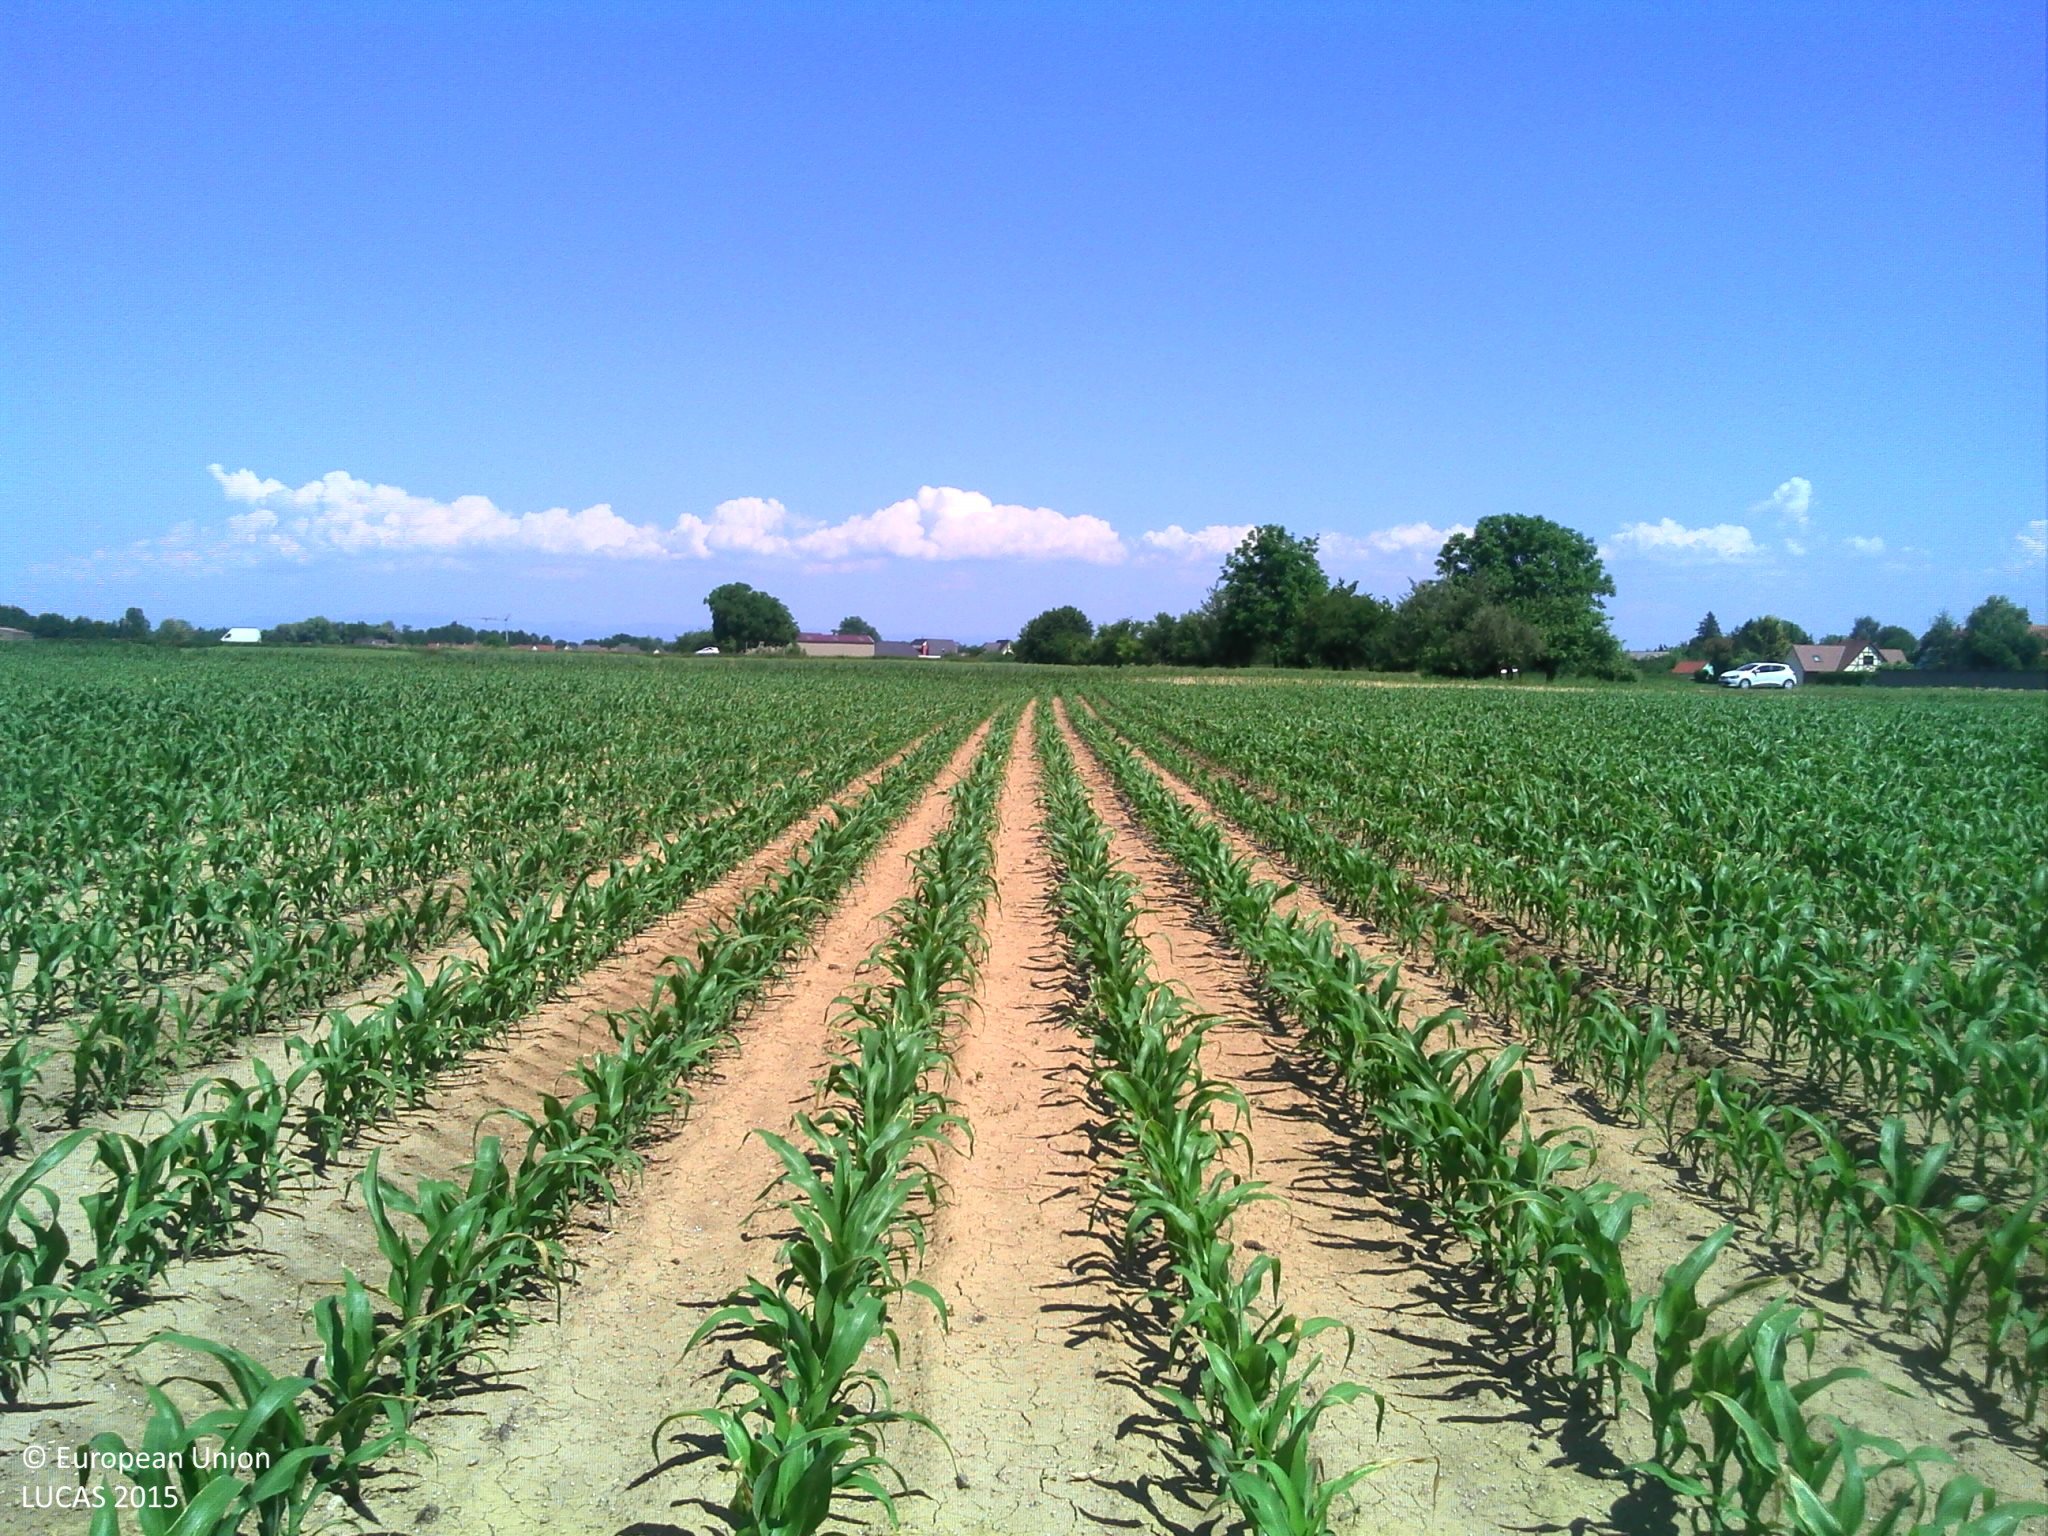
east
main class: Cropland
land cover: Maize
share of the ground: 10 - 25 %
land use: Agriculture (excluding fallow land and kitchen gardens)
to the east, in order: Maize; Grass margins; Tracks; Grass margins; Common wheat; Apple fruit; Maize
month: June
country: FR
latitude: 48.4508
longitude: 7.6618
